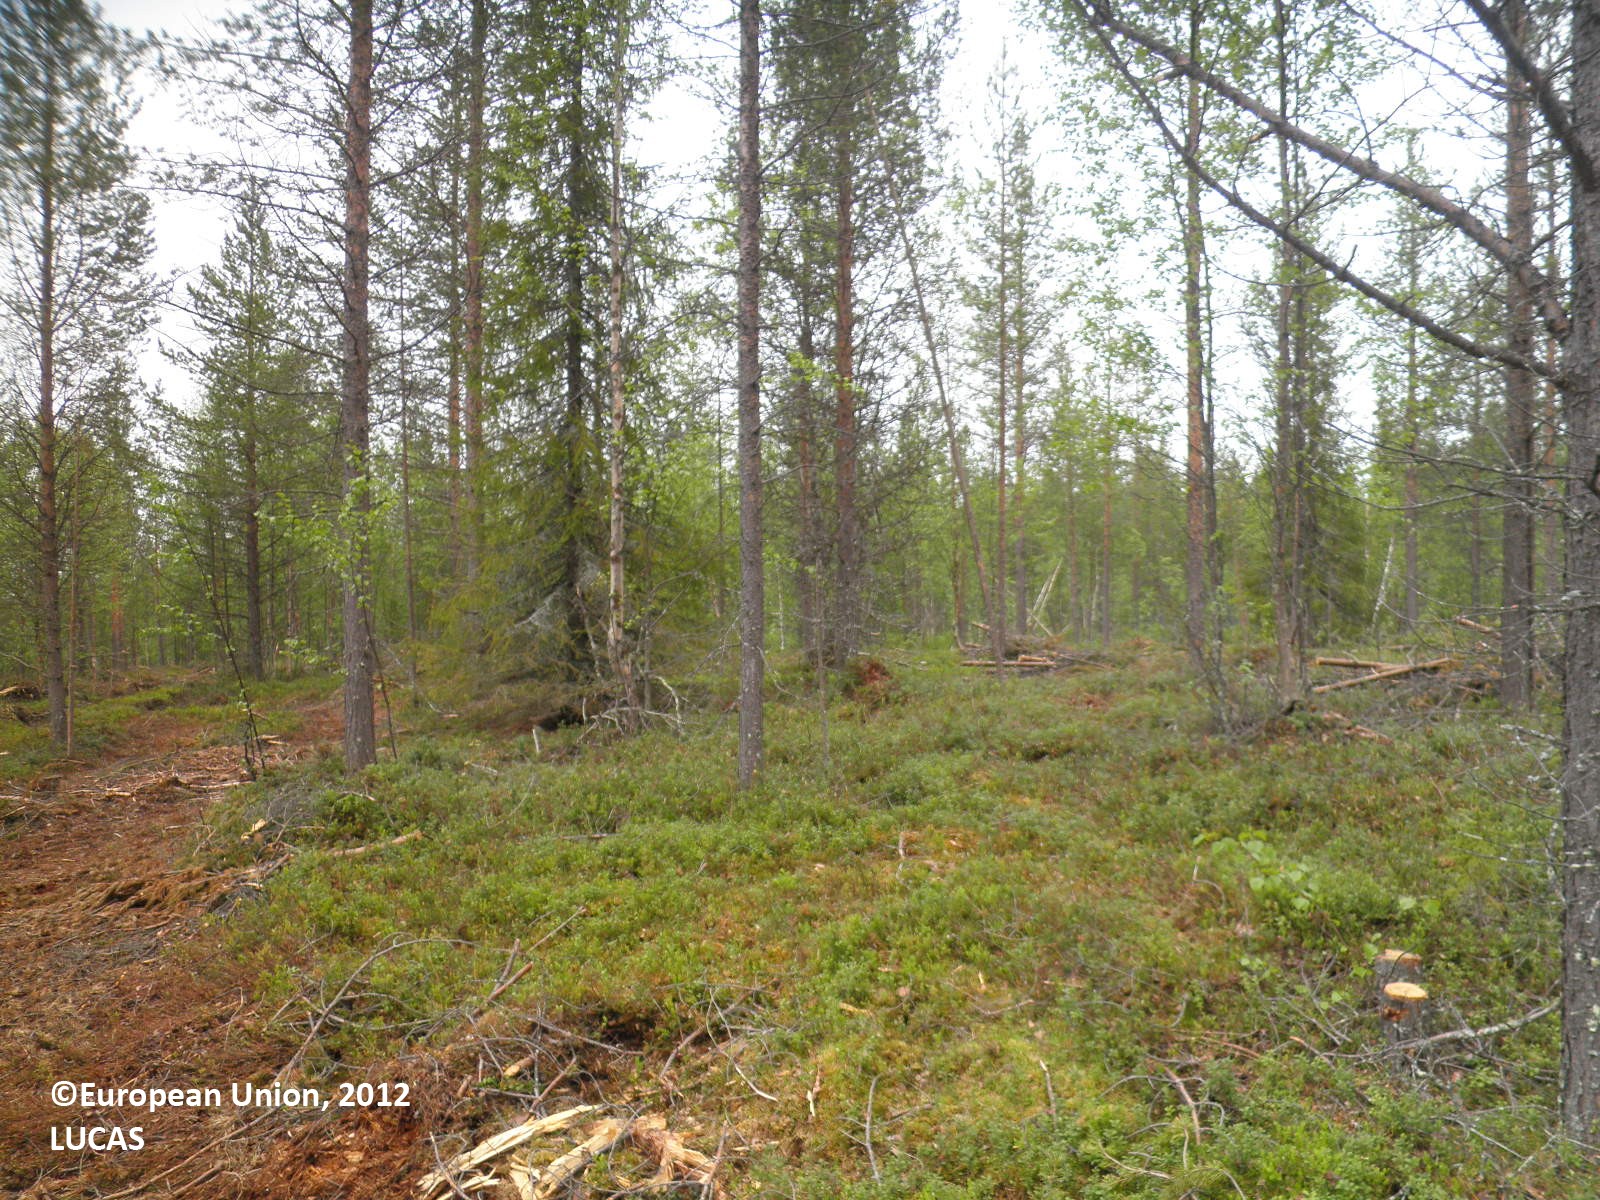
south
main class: Woodland
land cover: Pine dominated coniferous woodland
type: boreal forest
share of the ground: 25 - 50 %
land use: Forestry
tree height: > 5 m
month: June
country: FI
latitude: 67.8137
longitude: 25.5408
